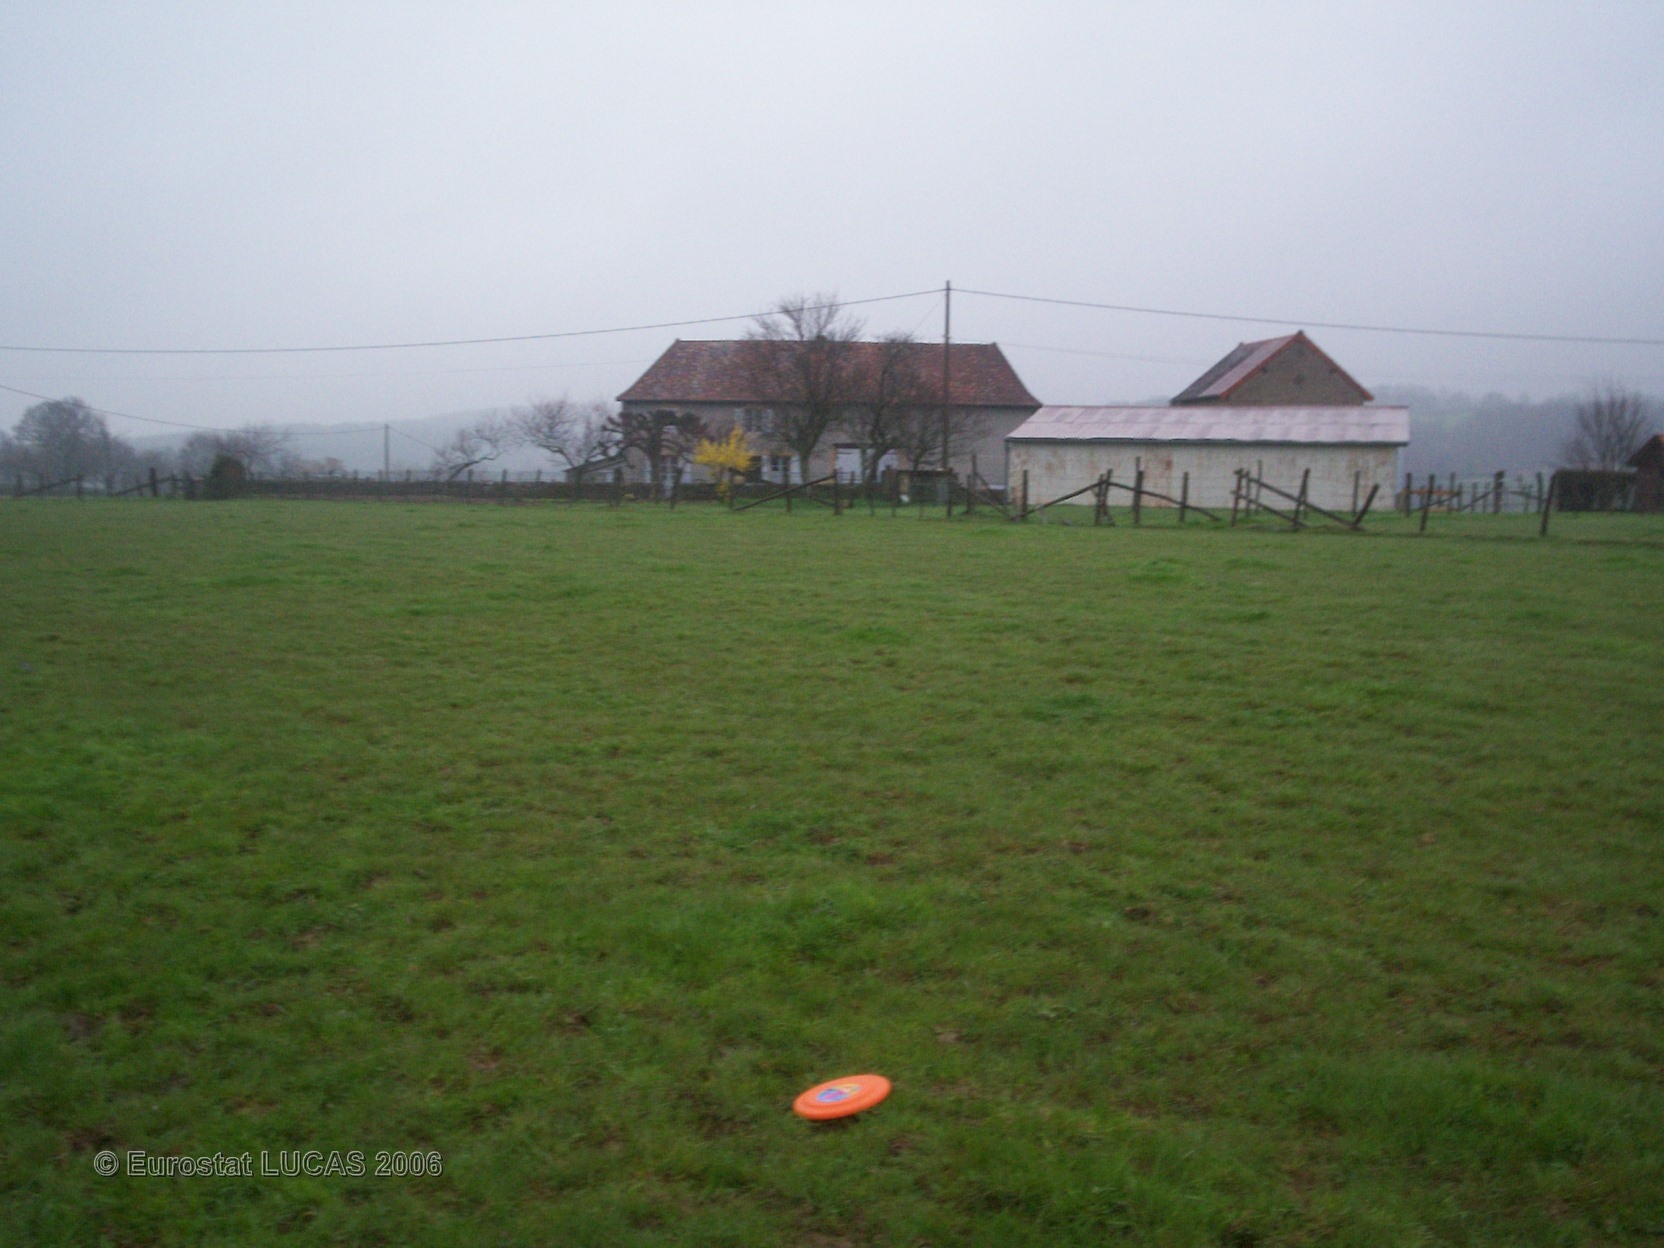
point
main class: Grassland
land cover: Grassland without tree/shrub cover
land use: Agriculture (excluding fallow land and kitchen gardens)
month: April
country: FR
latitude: 46.2770
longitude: 4.0703
